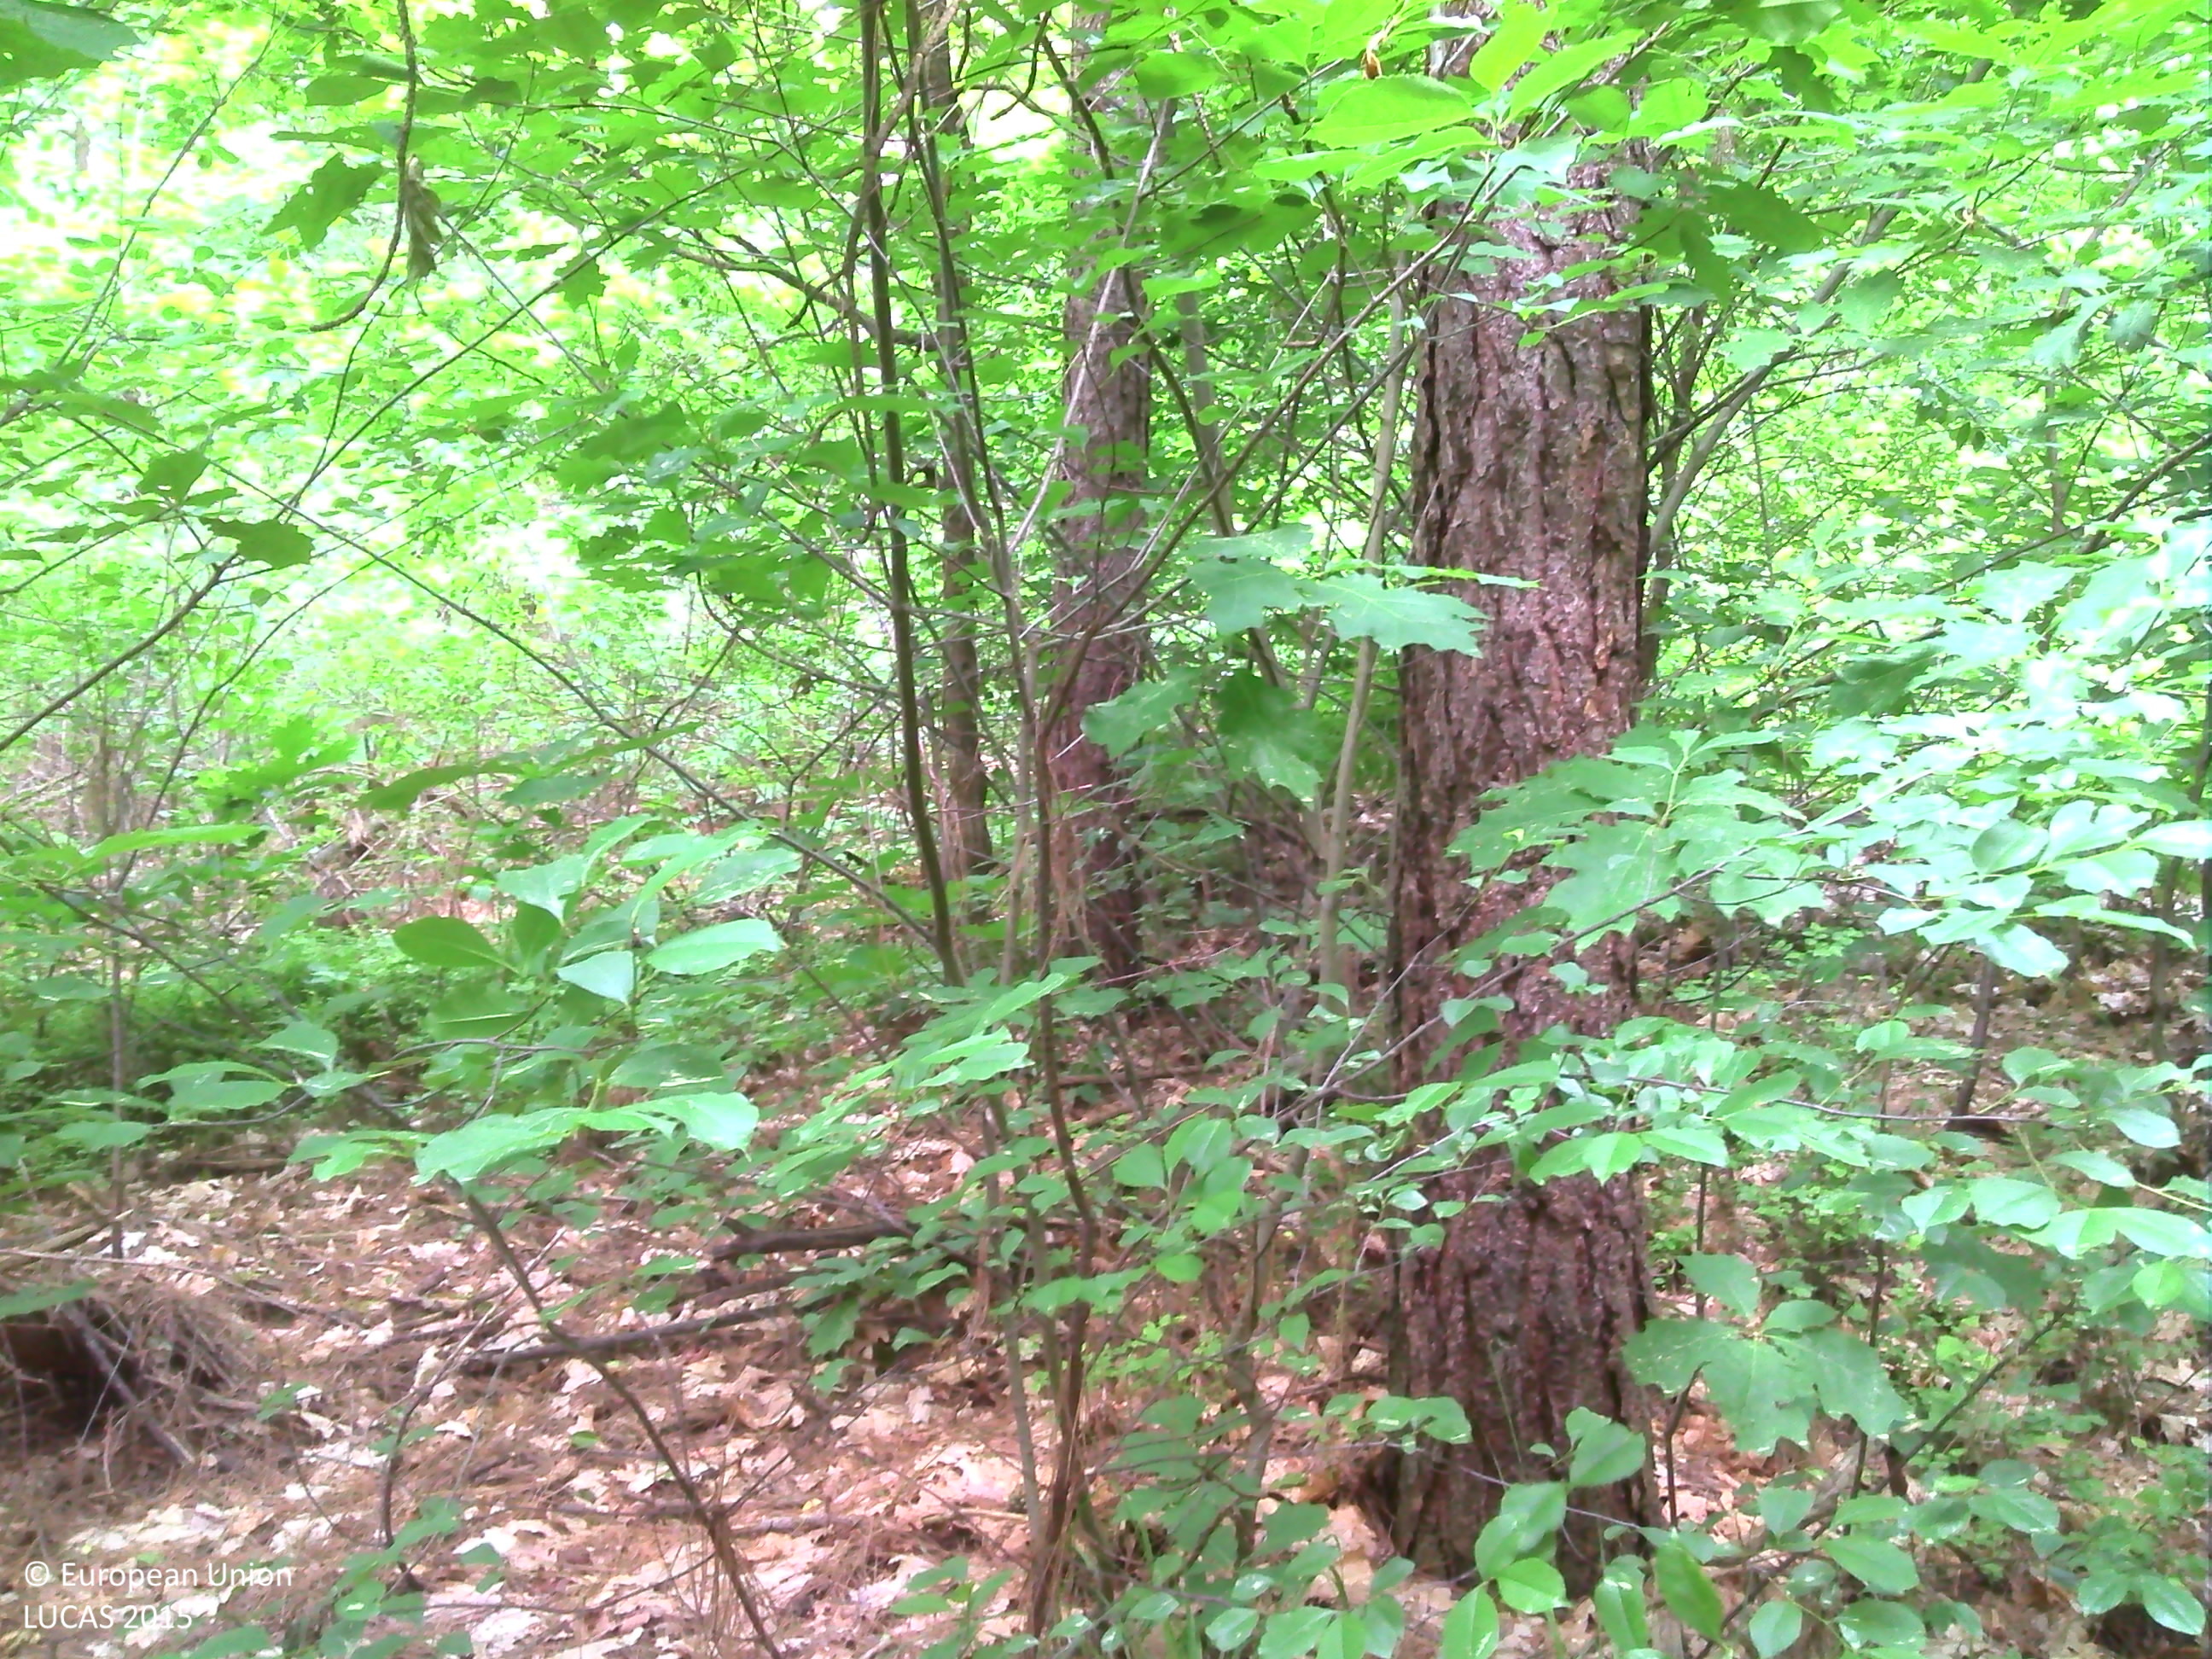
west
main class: Woodland
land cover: Pine dominated mixed woodland
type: acidophilous oak and oak-birch forest
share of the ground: > 75 %
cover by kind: broadleaved forest trees 70 %, coniferous forest trees 25 %, herbaceous plants 5 %
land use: Forestry
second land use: Sport
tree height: > 5 m
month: June
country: BE
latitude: 51.0207
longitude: 5.6789
